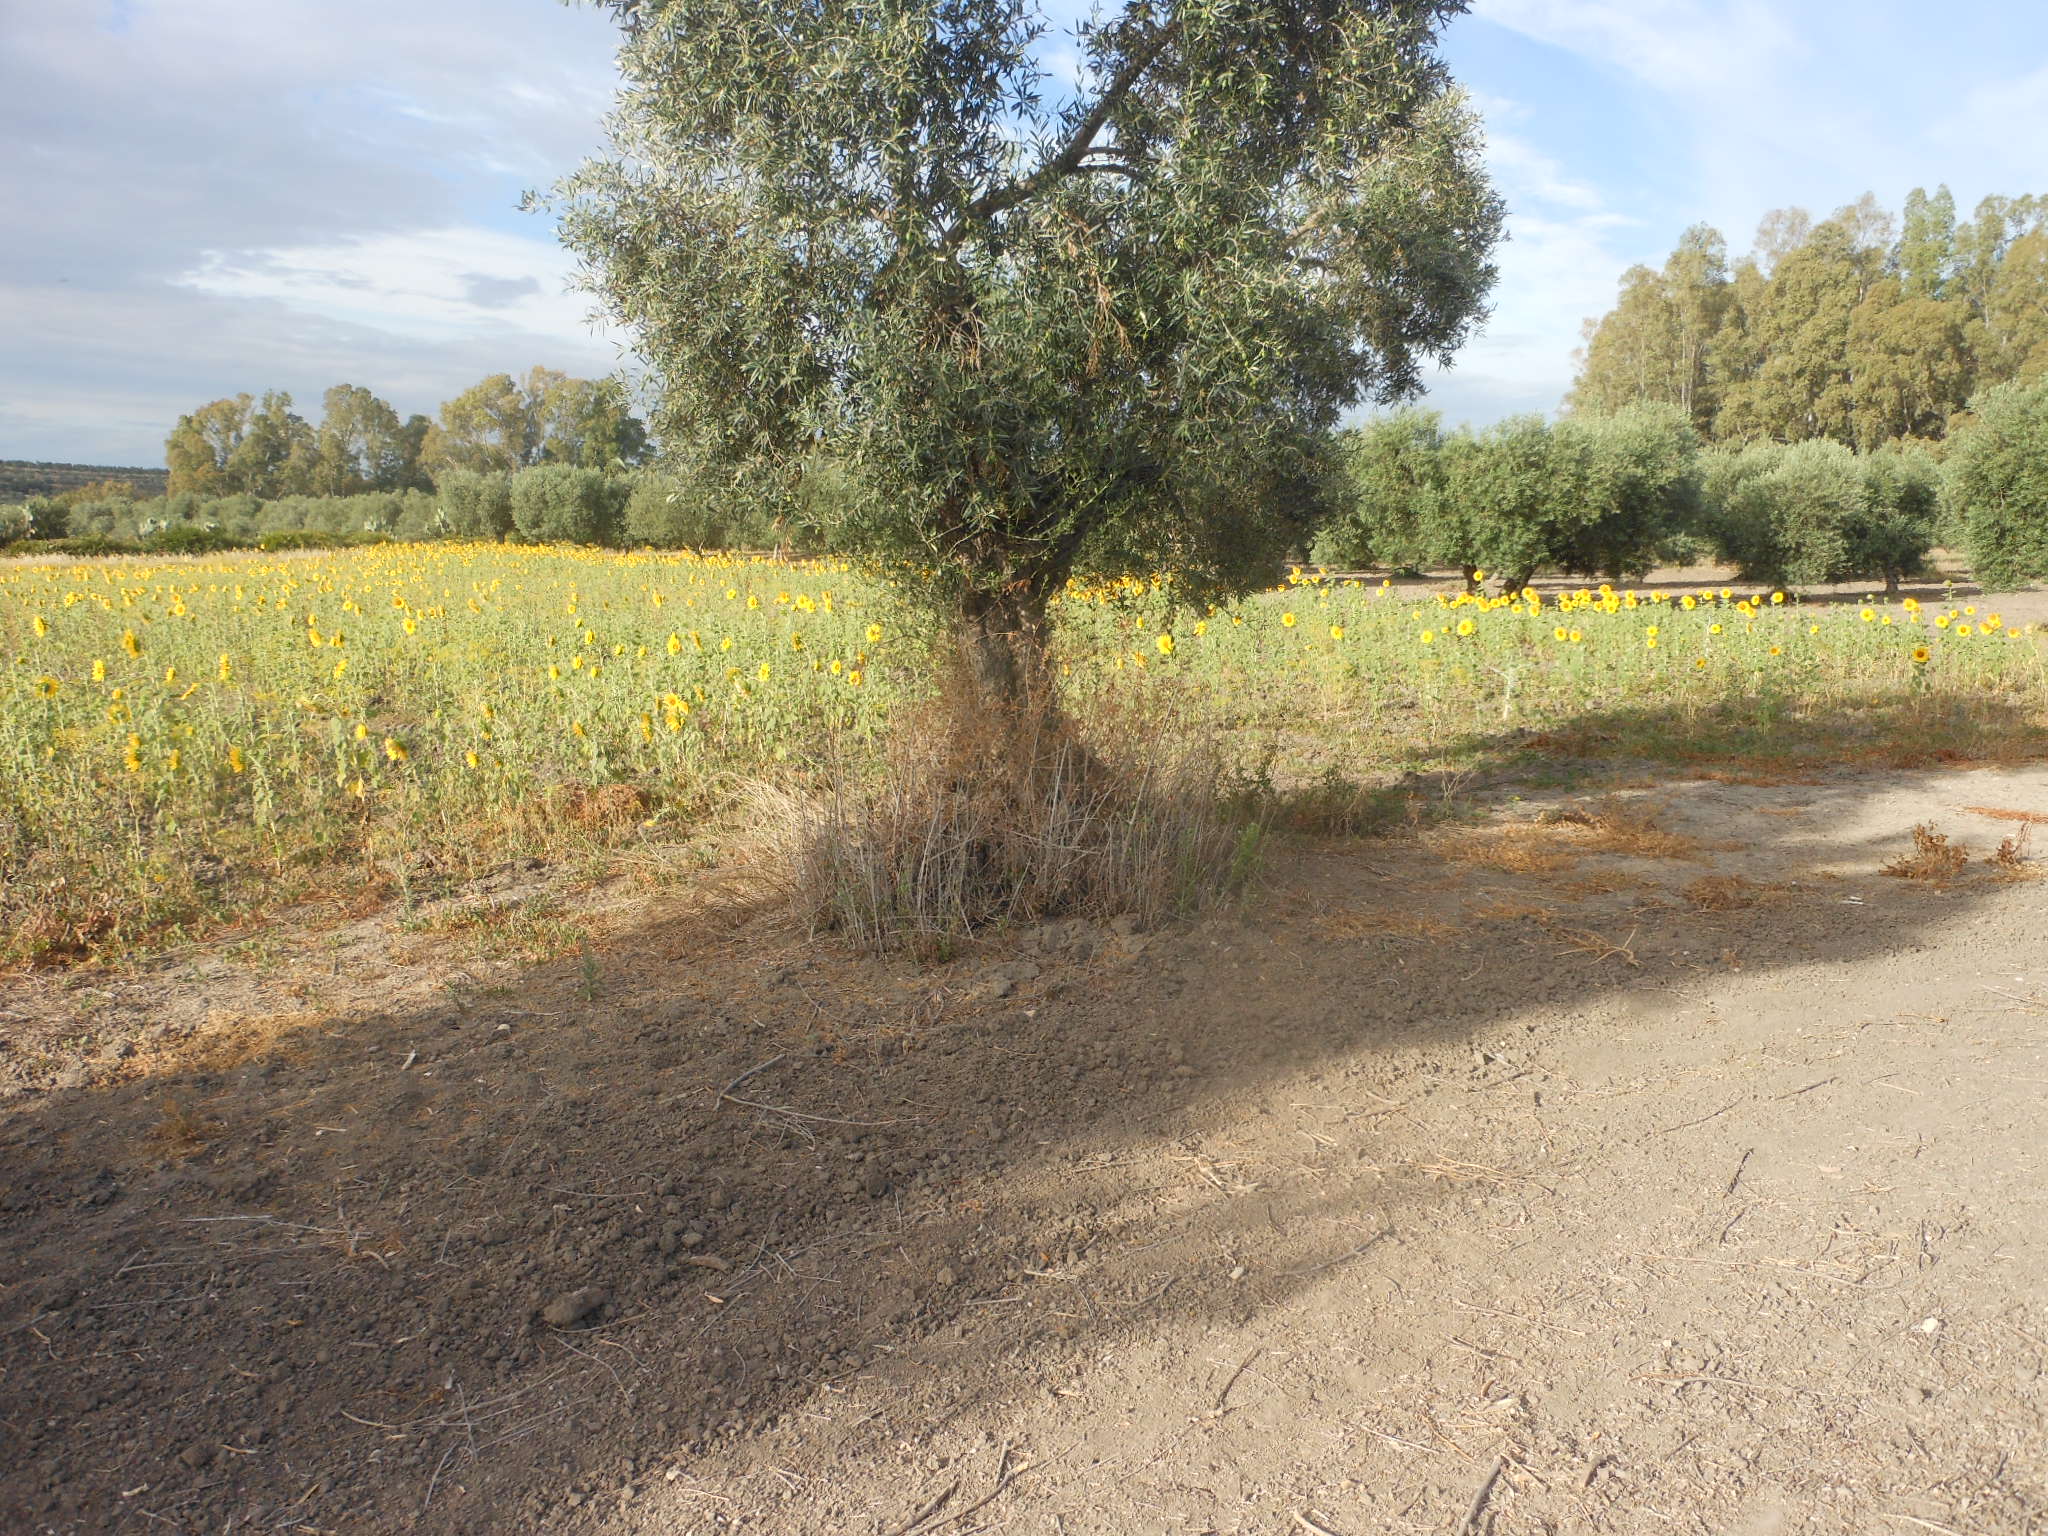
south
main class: Cropland
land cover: Olive groves
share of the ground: 50 - 75 %
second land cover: Other bare soil
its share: > 75 %
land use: Agriculture (excluding fallow land and kitchen gardens)
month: June
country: ES
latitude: 37.2362
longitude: -5.5352
